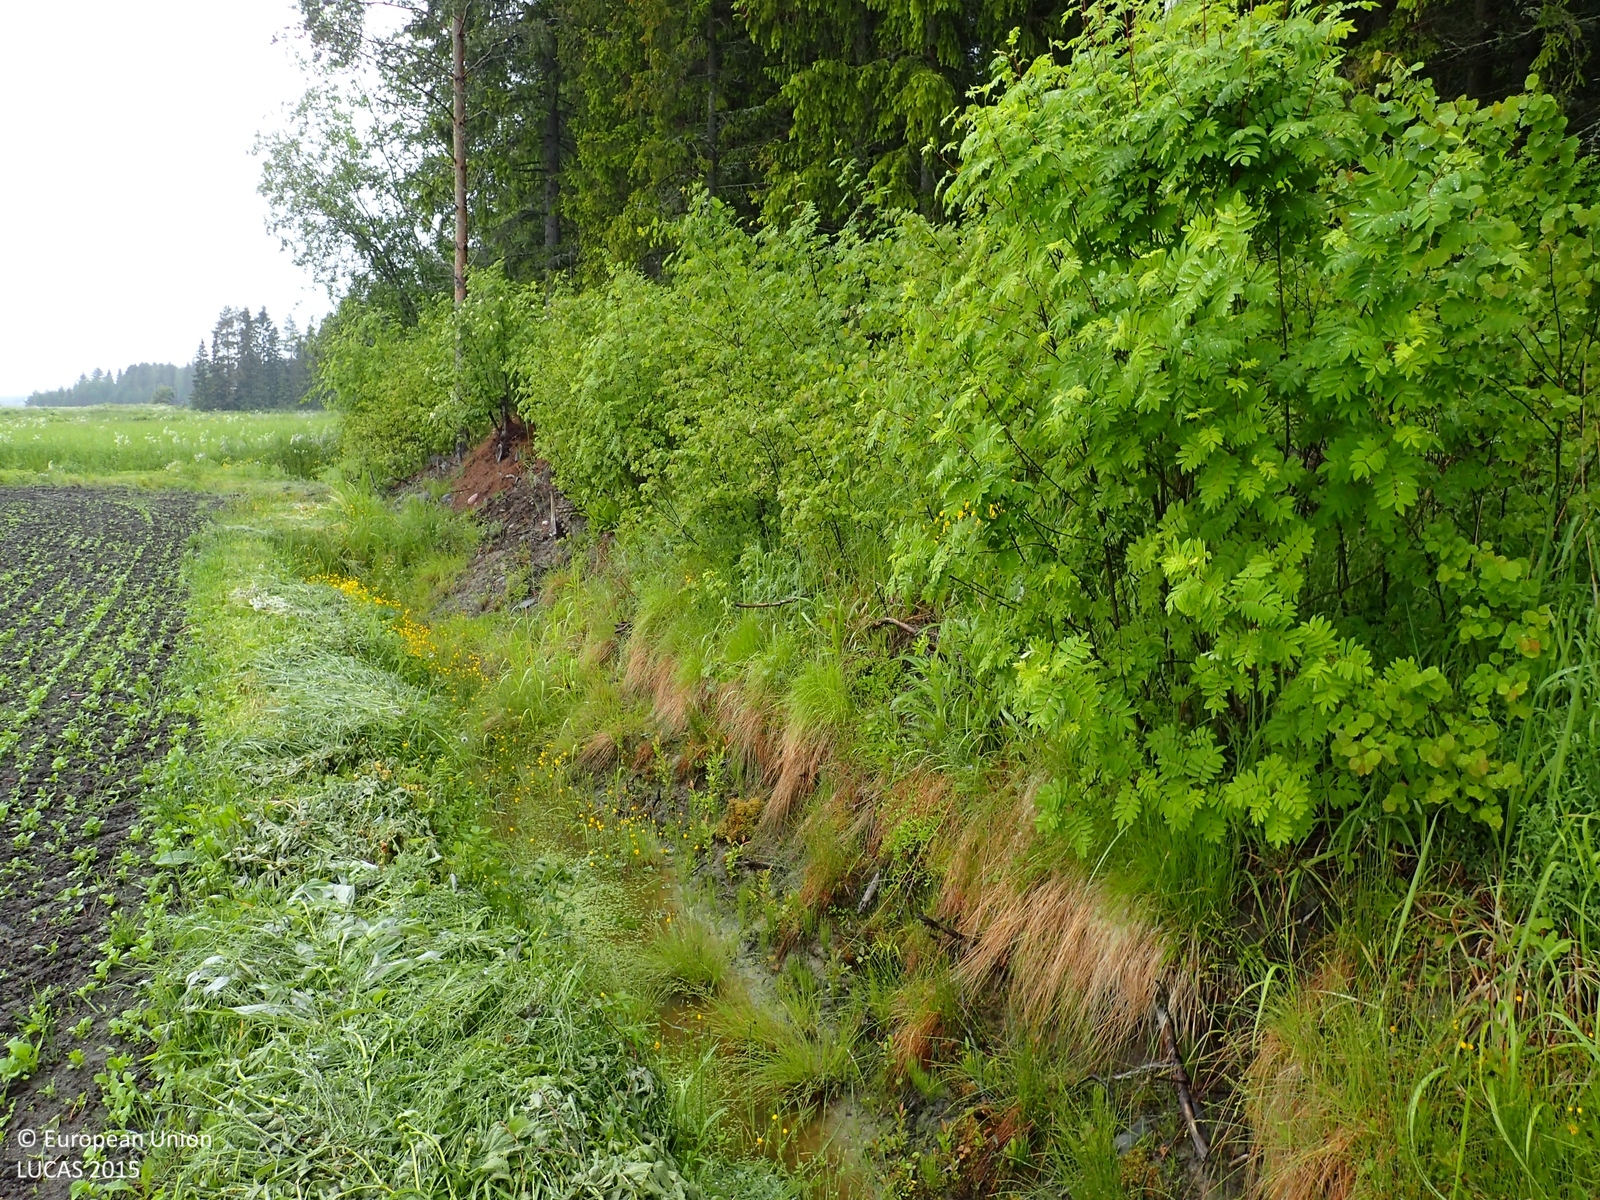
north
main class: Cropland
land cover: Rape and turnip rape
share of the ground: 50 - 75 %
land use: Agriculture (excluding fallow land and kitchen gardens)
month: June
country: FI
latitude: 62.2199
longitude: 21.5664
